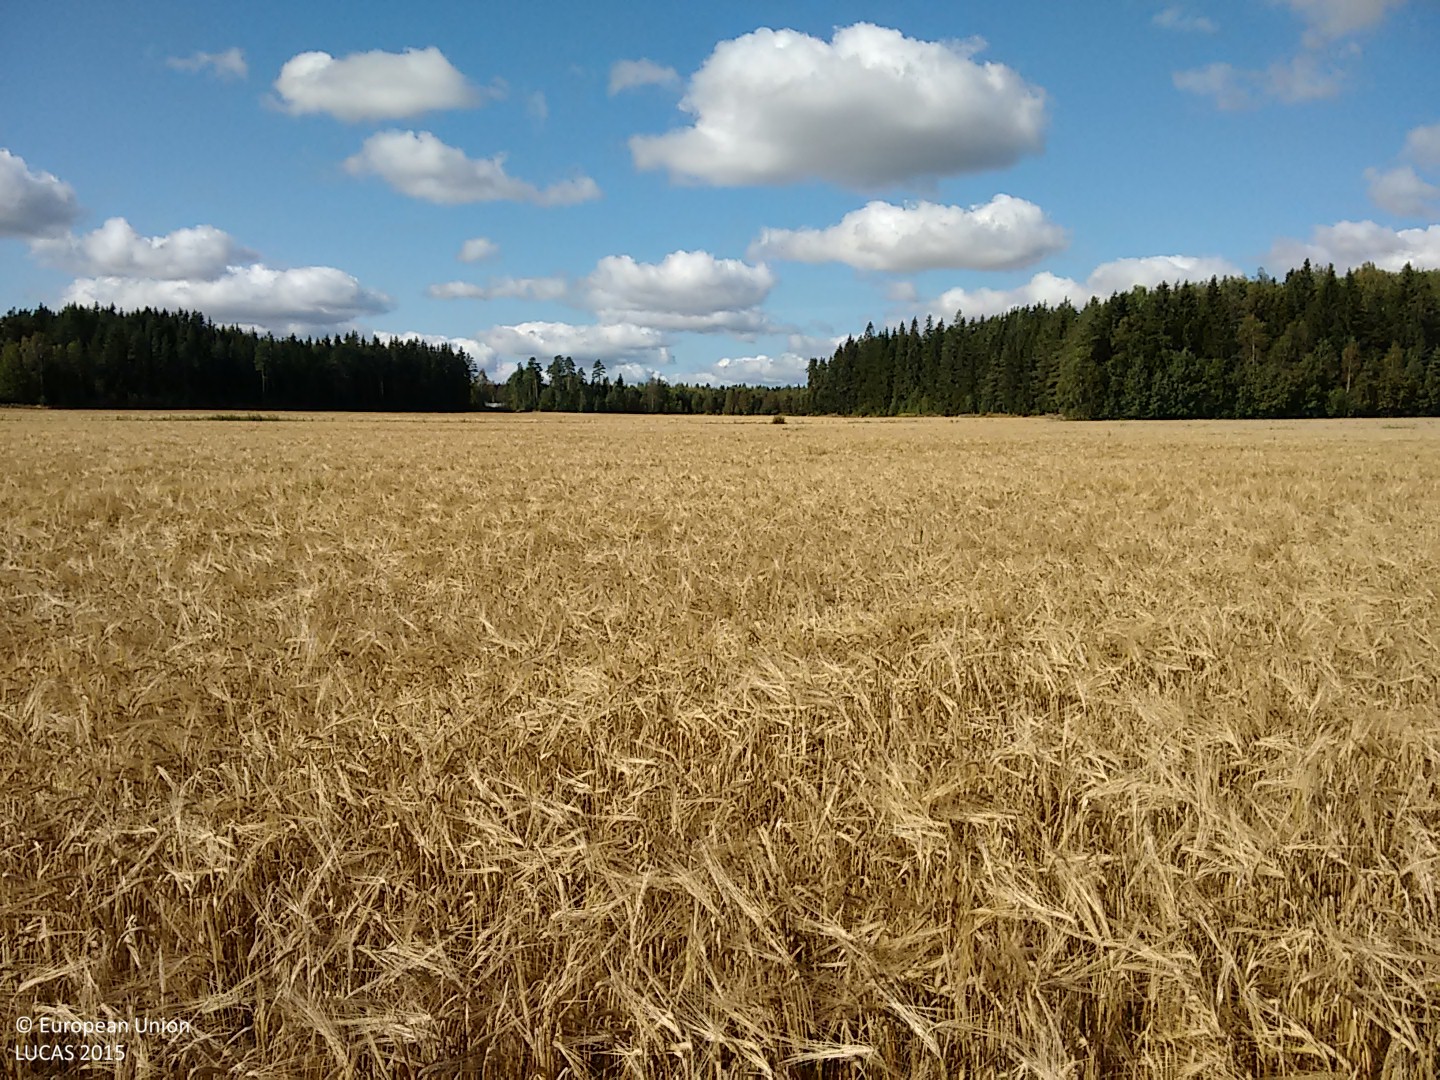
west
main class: Cropland
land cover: Barley
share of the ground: > 75 %
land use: Agriculture (excluding fallow land and kitchen gardens)
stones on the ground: < 10 %
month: September
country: FI
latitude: 60.8697
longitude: 21.7887
